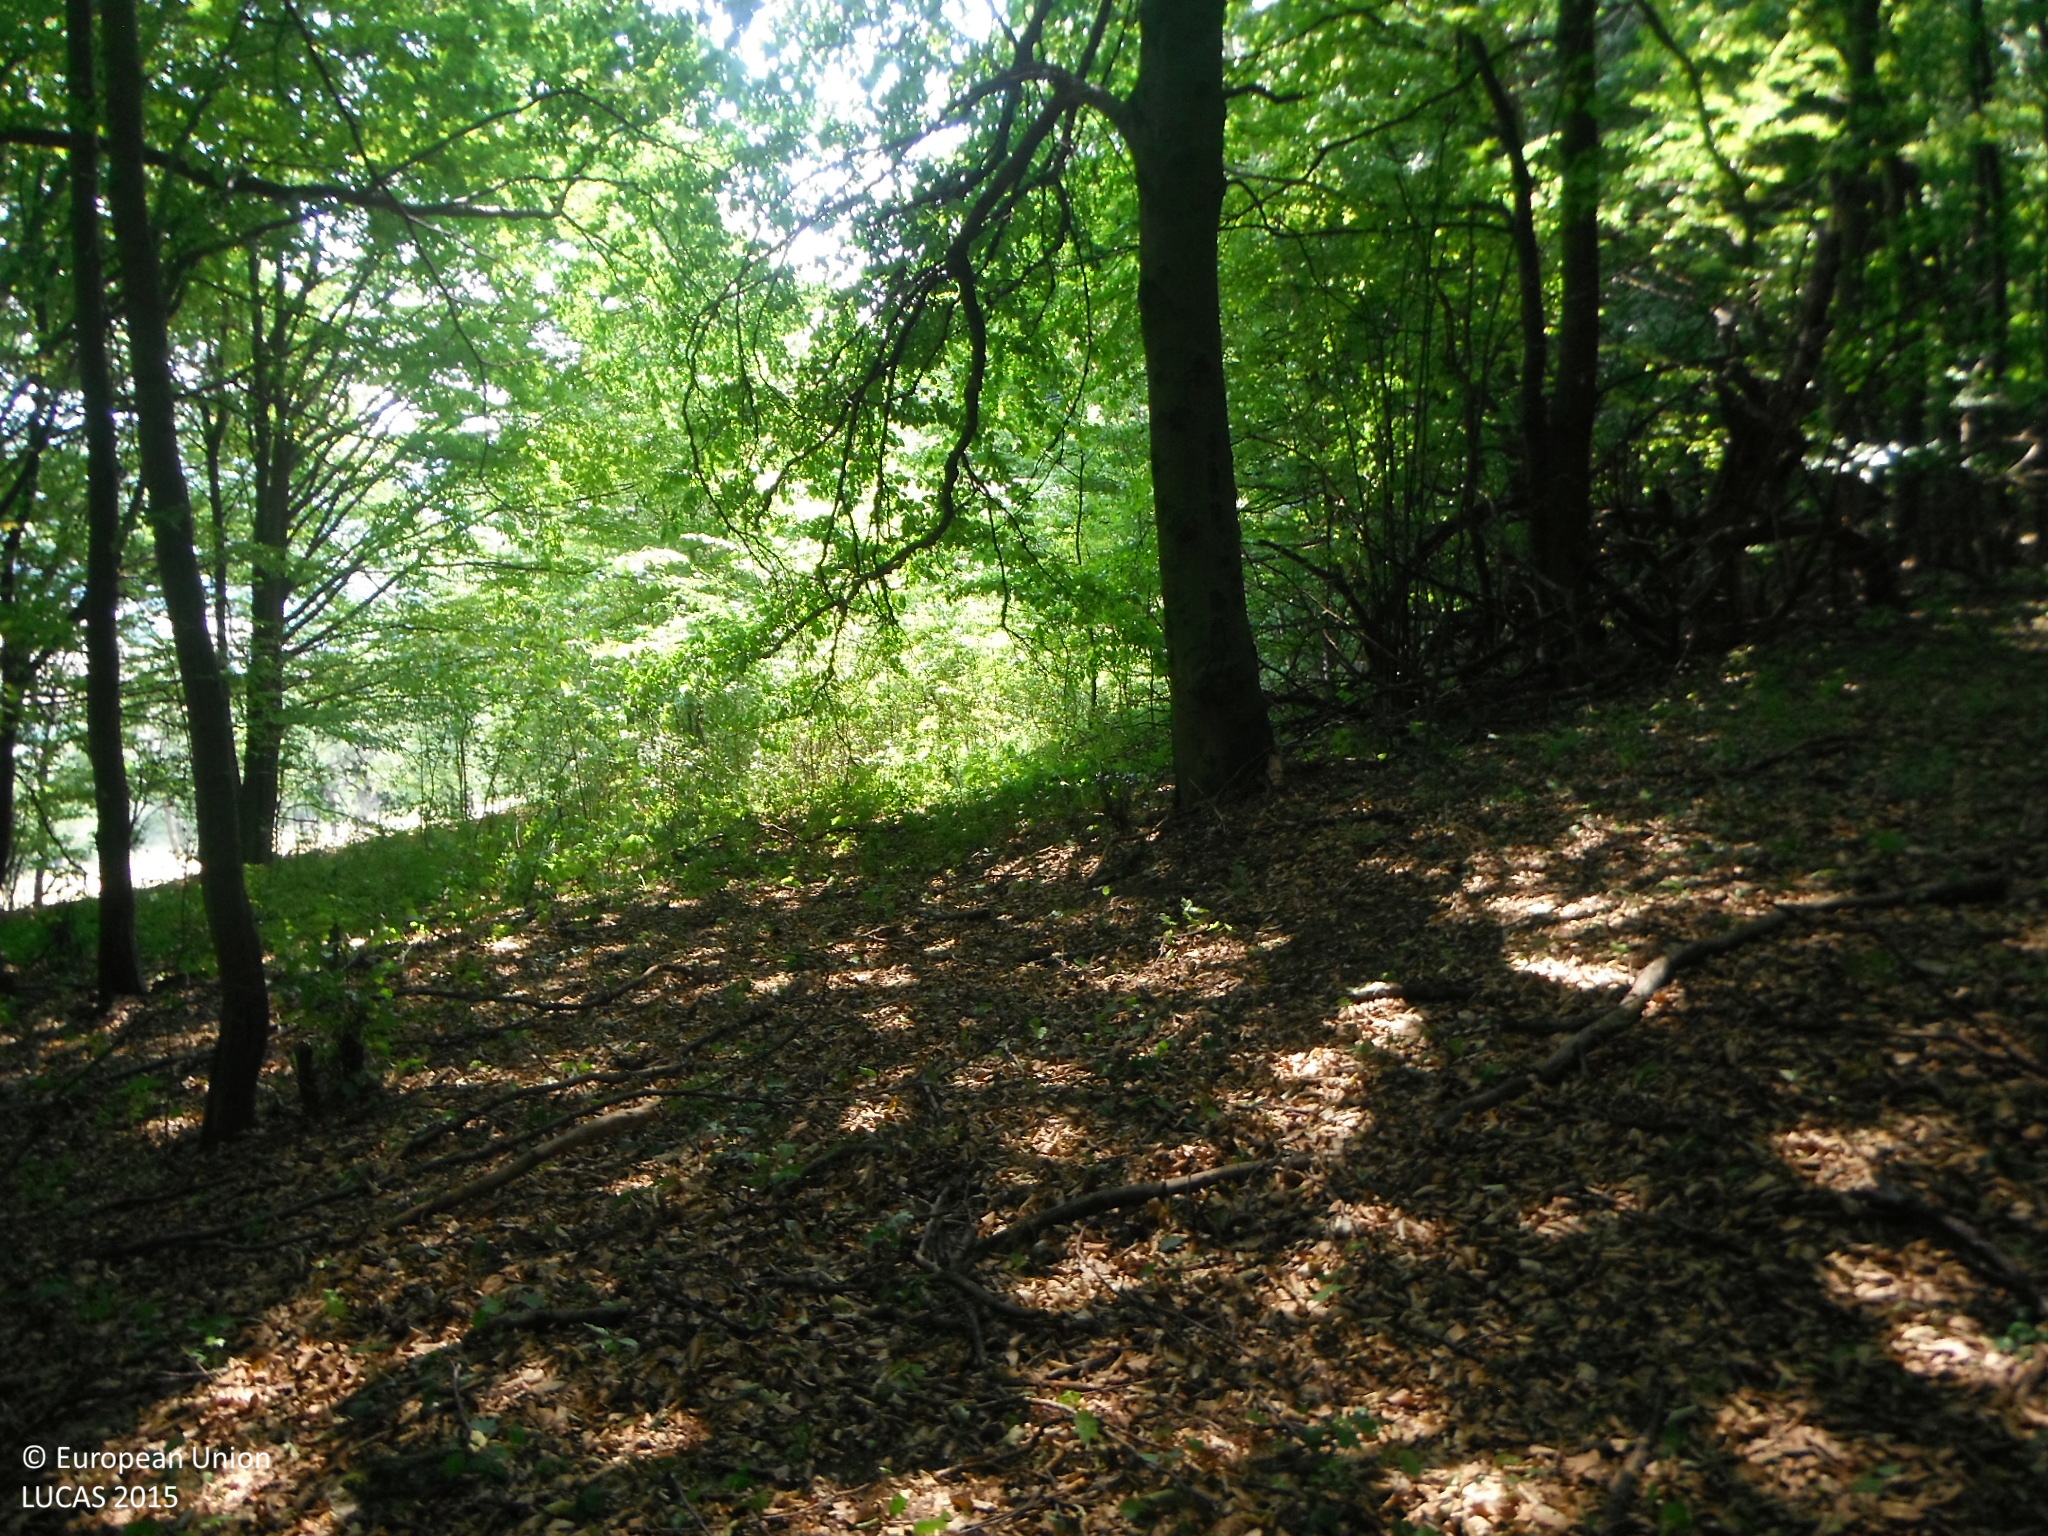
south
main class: Woodland
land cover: Broadleaved woodland
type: beech forest
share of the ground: > 75 %
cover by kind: broadleaved forest trees 90 %, shrubs 5 %, herbaceous plants 5 %
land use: Forestry
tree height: > 5 m
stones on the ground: 10 - 25 %
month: August
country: SK
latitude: 48.6748
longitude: 17.9855
